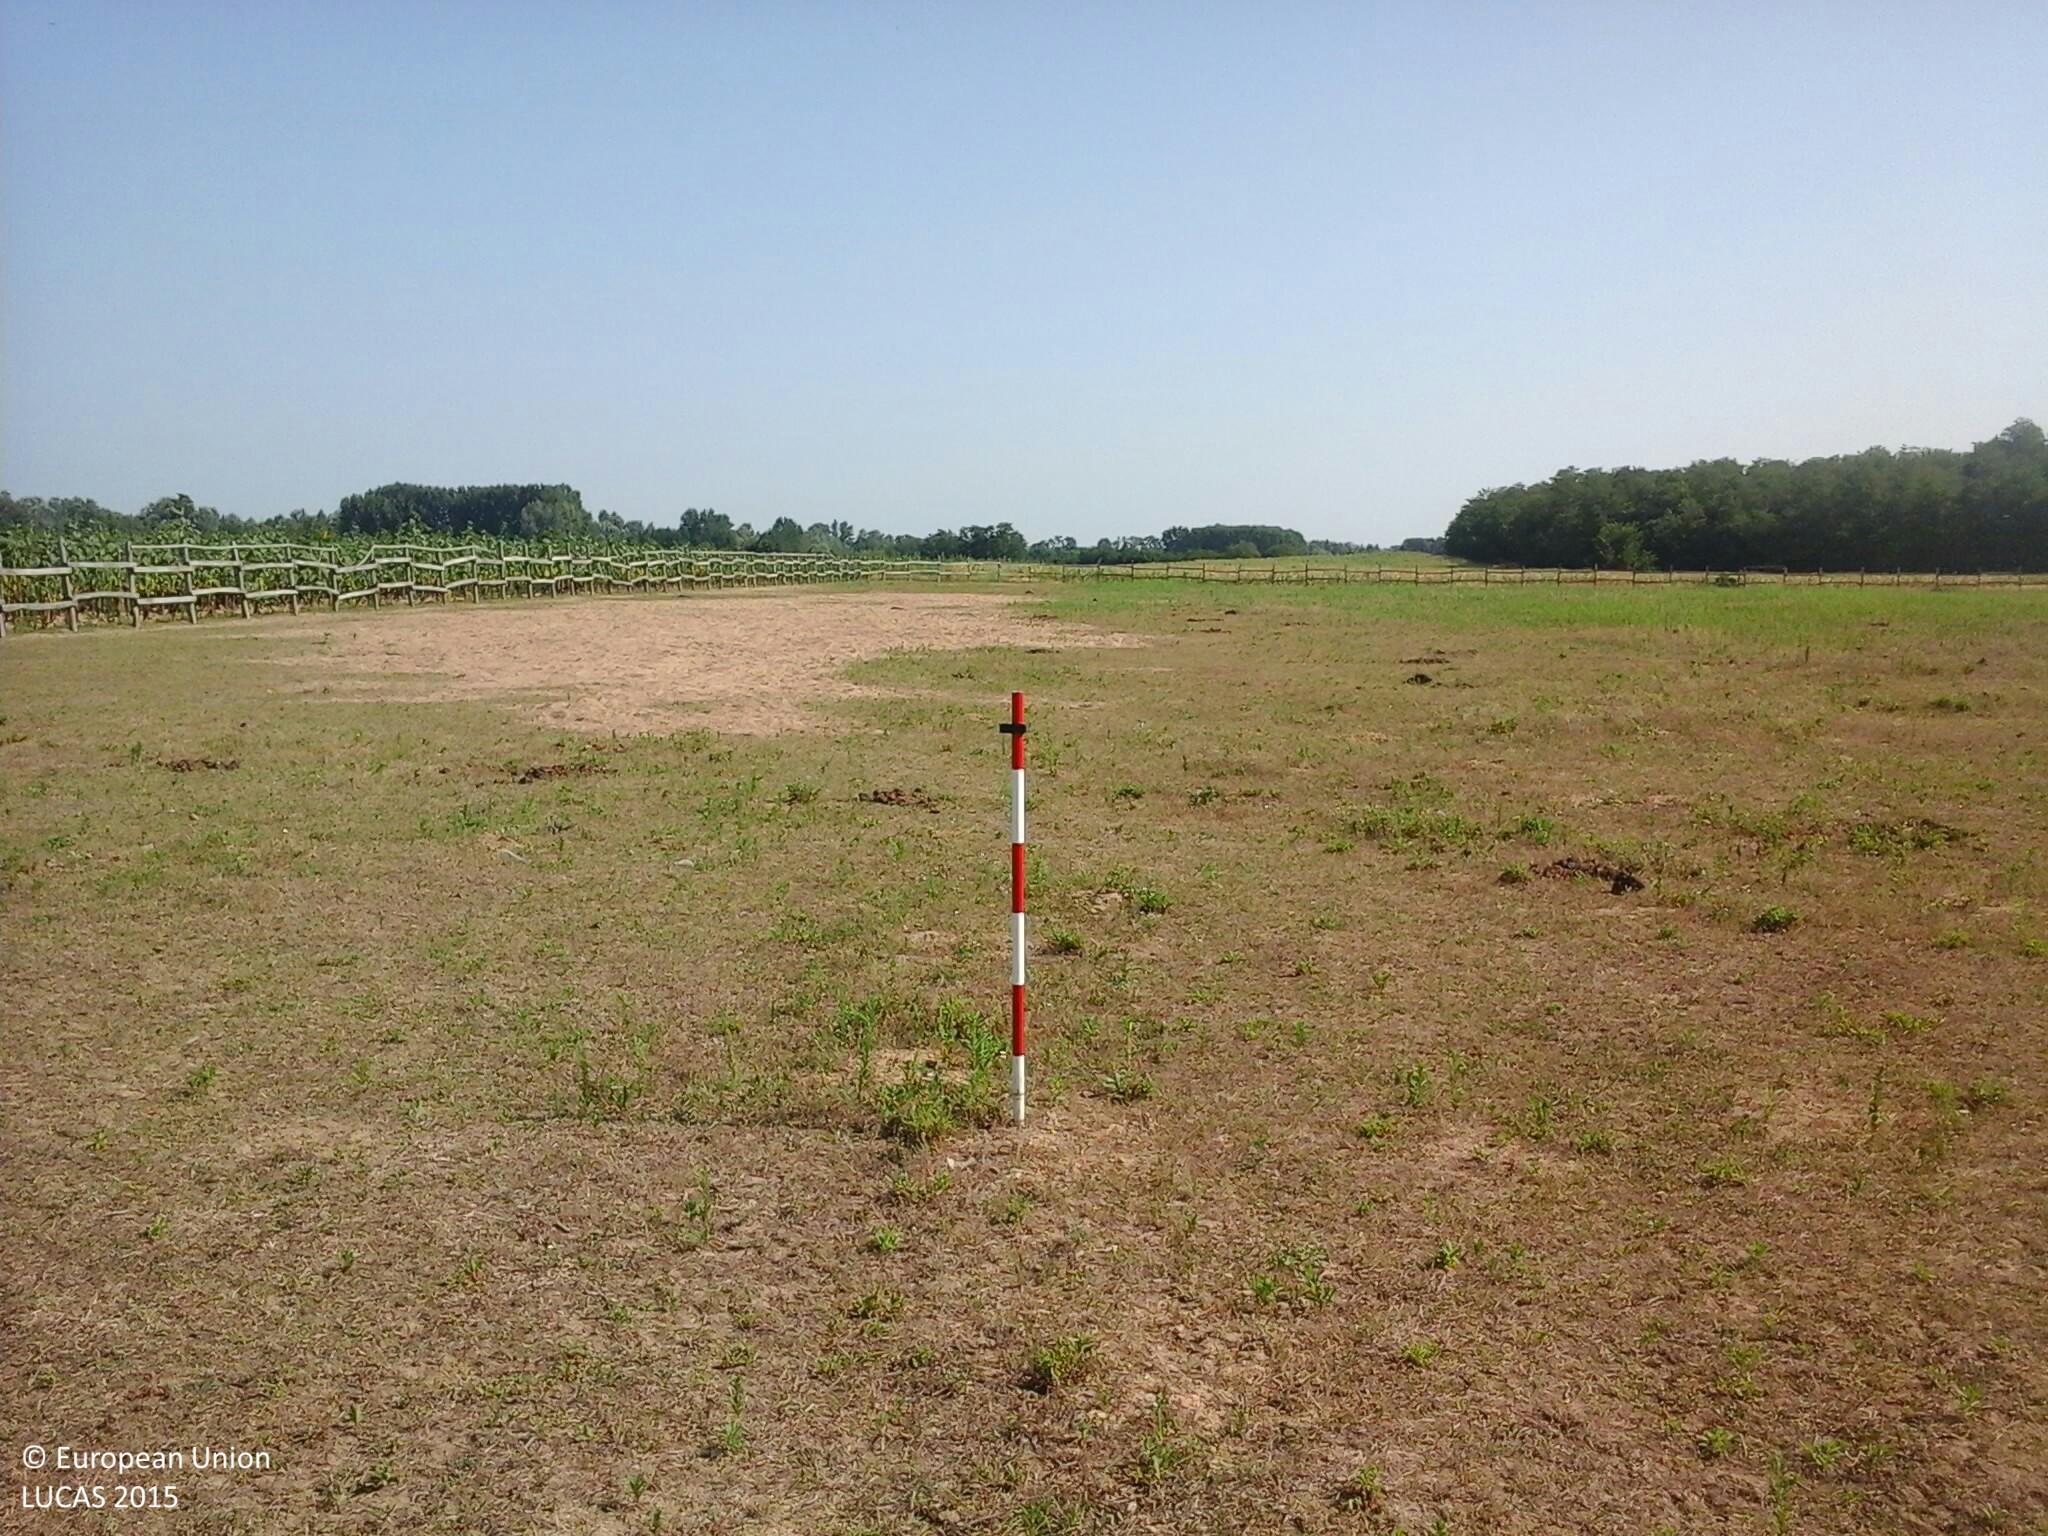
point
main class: Grassland
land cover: Grassland without tree/shrub cover
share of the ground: > 75 %
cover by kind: herbaceous plants 75 %, unconsolidated bare surface 20 %, shrubs 5 %
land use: Agriculture (excluding fallow land and kitchen gardens)
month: July
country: HU
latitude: 47.8549
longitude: 22.3390
